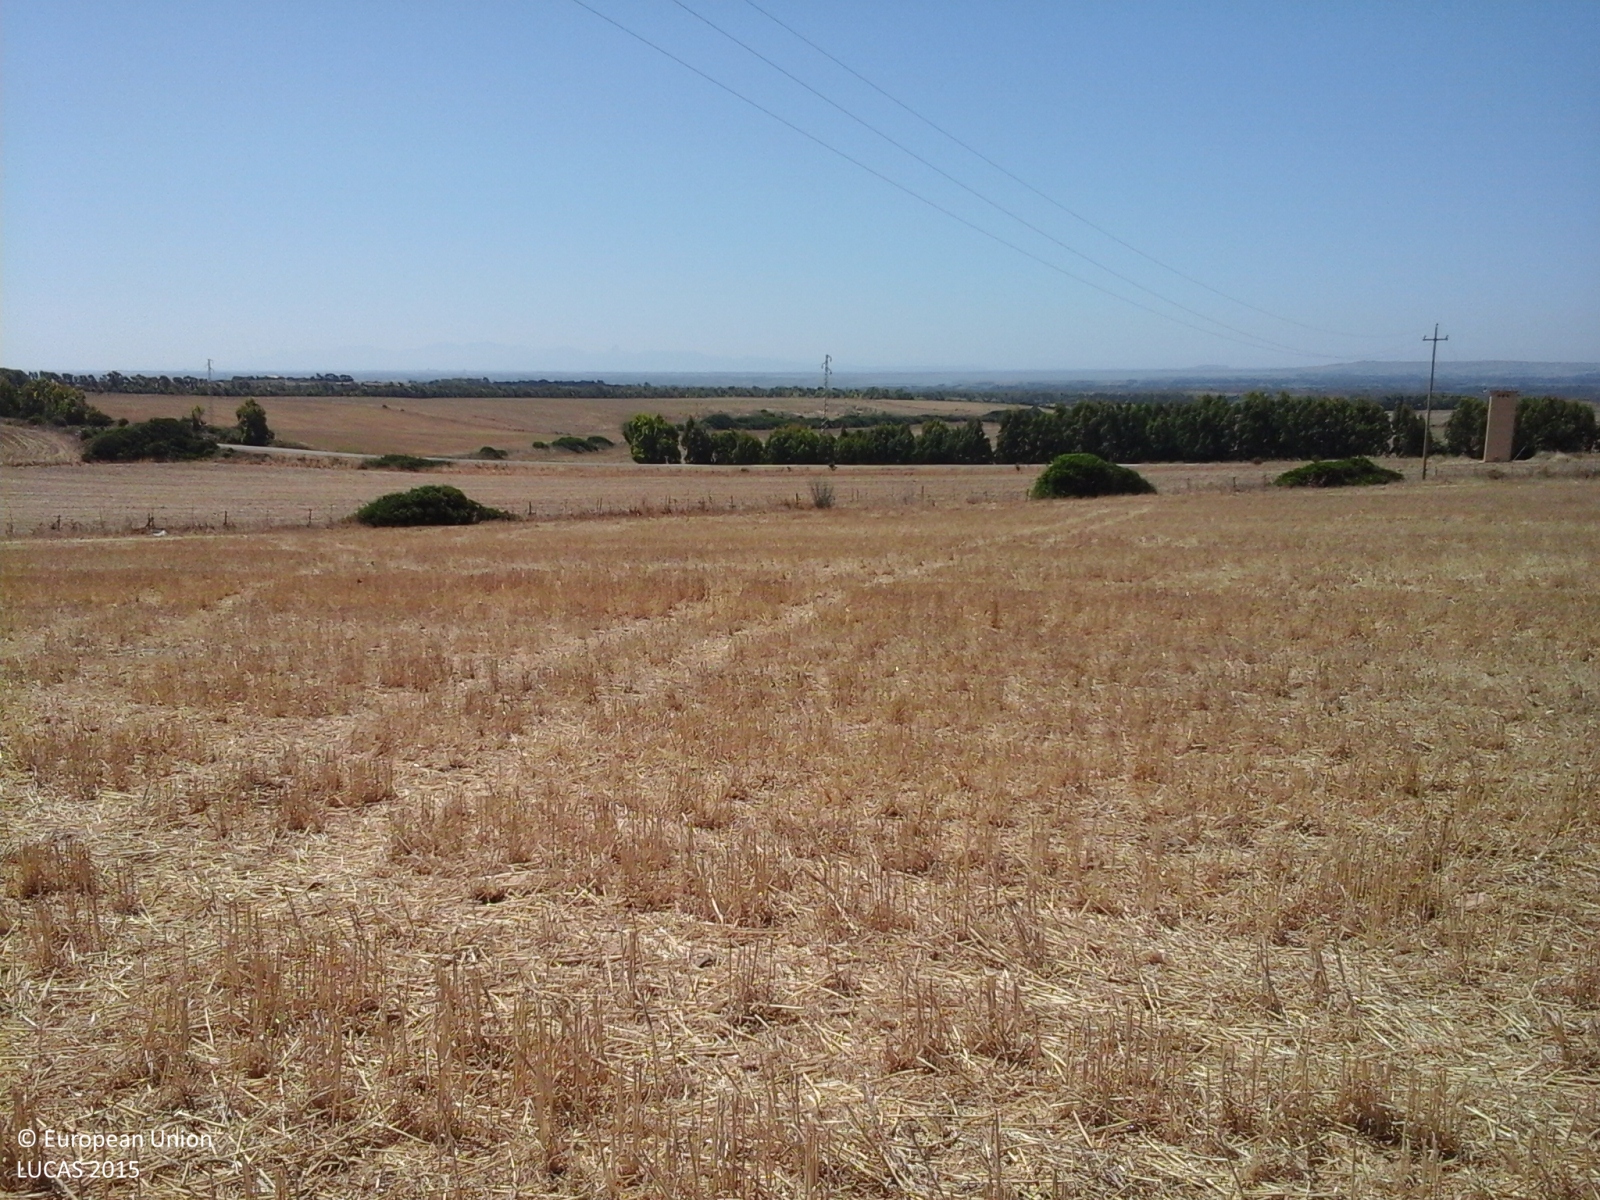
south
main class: Cropland
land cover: Durum wheat
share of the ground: > 75 %
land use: Agriculture (excluding fallow land and kitchen gardens)
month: August
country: IT
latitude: 40.0570
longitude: 8.5192
